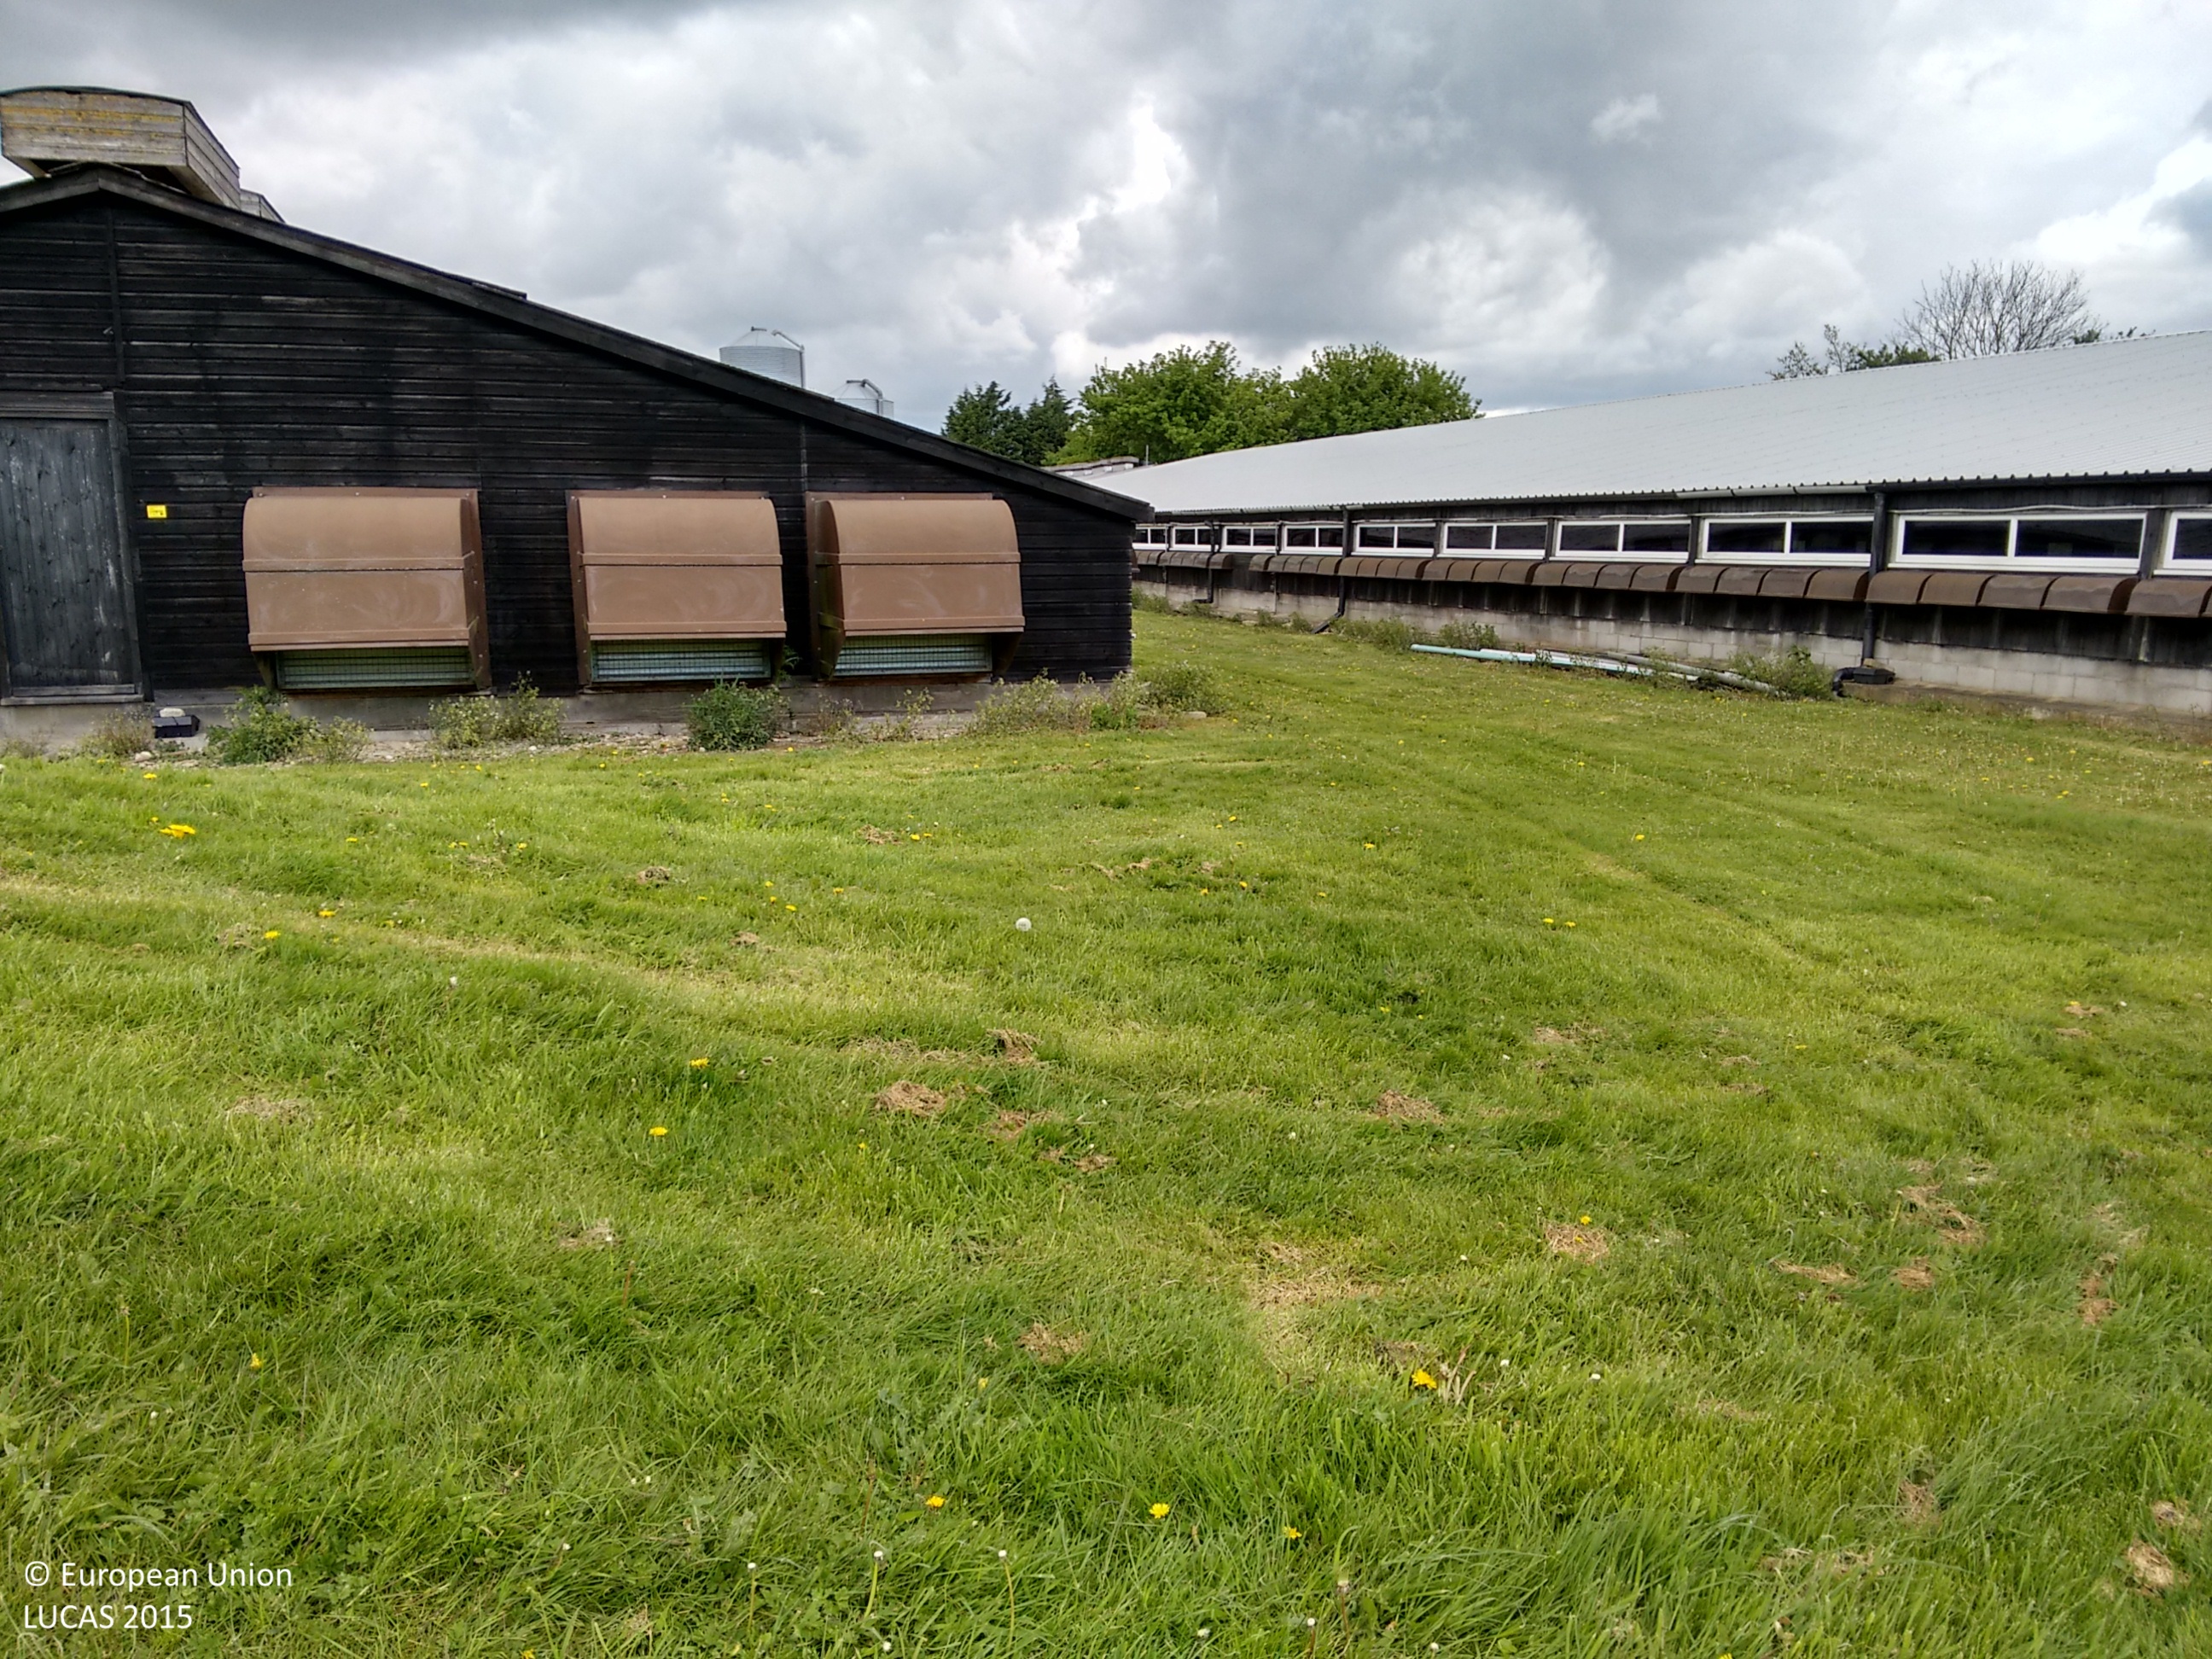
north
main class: Grassland
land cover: Grassland without tree/shrub cover
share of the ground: > 75 %
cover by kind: herbaceous plants 100 %
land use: Agriculture (excluding fallow land and kitchen gardens)
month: May
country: GB
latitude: 53.3860
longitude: -0.2129
